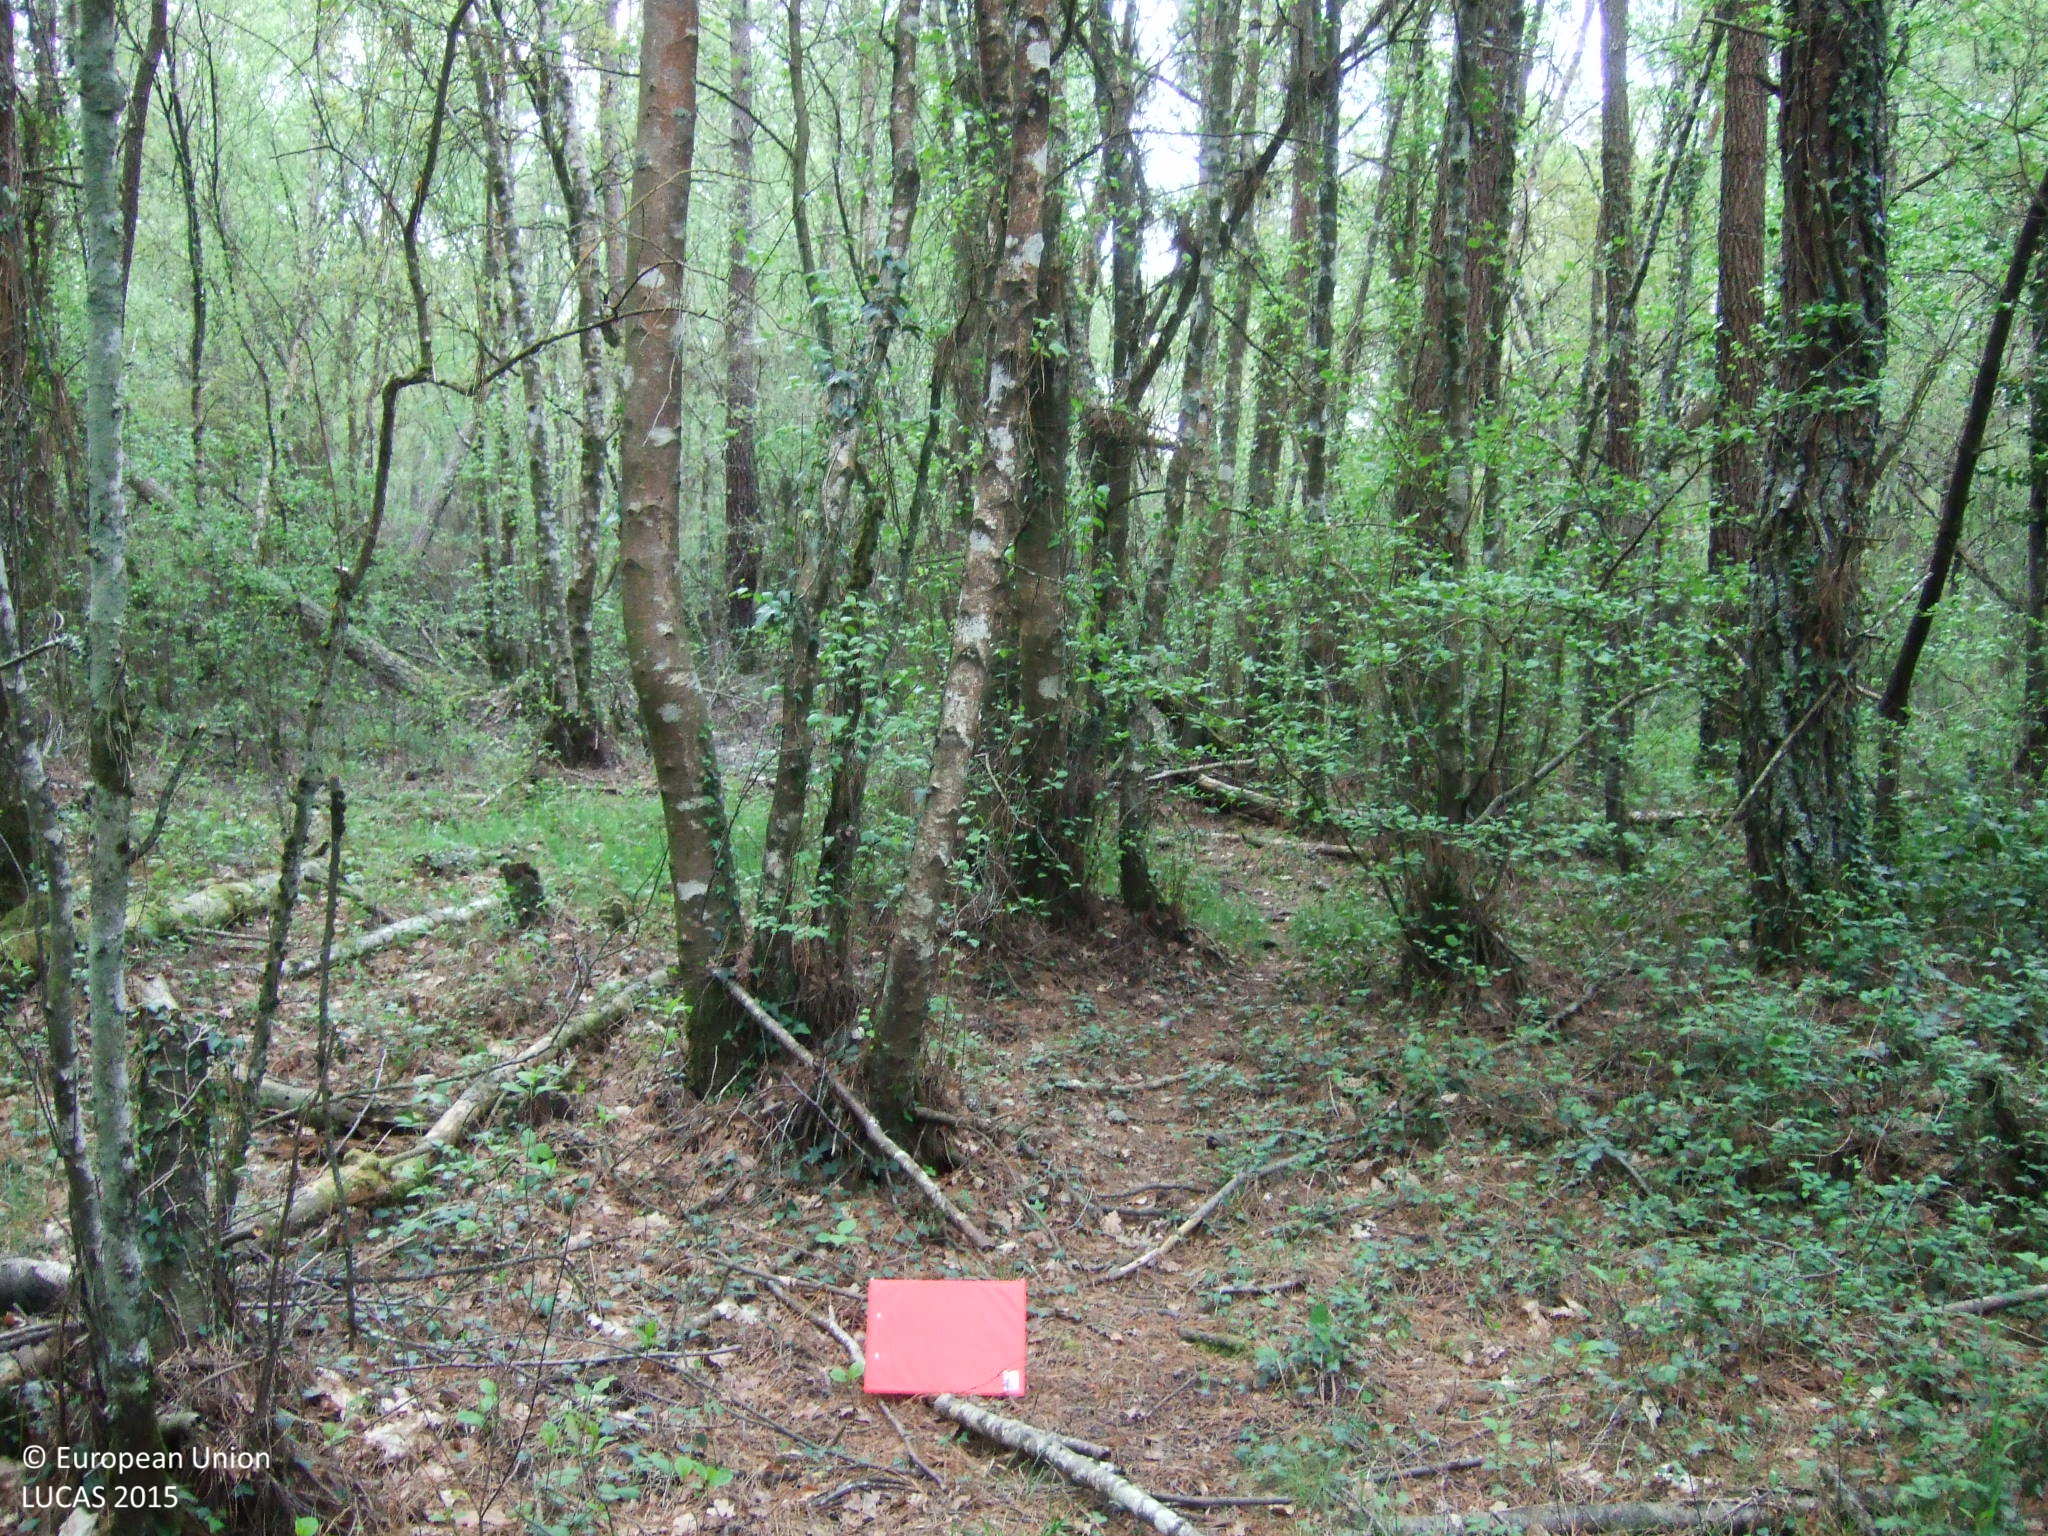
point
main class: Woodland
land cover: Other mixed woodland
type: acidophilous oak and oak-birch forest
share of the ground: > 75 %
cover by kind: broadleaved forest trees 50 %, coniferous forest trees 25 %, shrubs 25 %
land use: Forestry
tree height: > 5 m
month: April
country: ES
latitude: 43.1628
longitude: -7.7082
